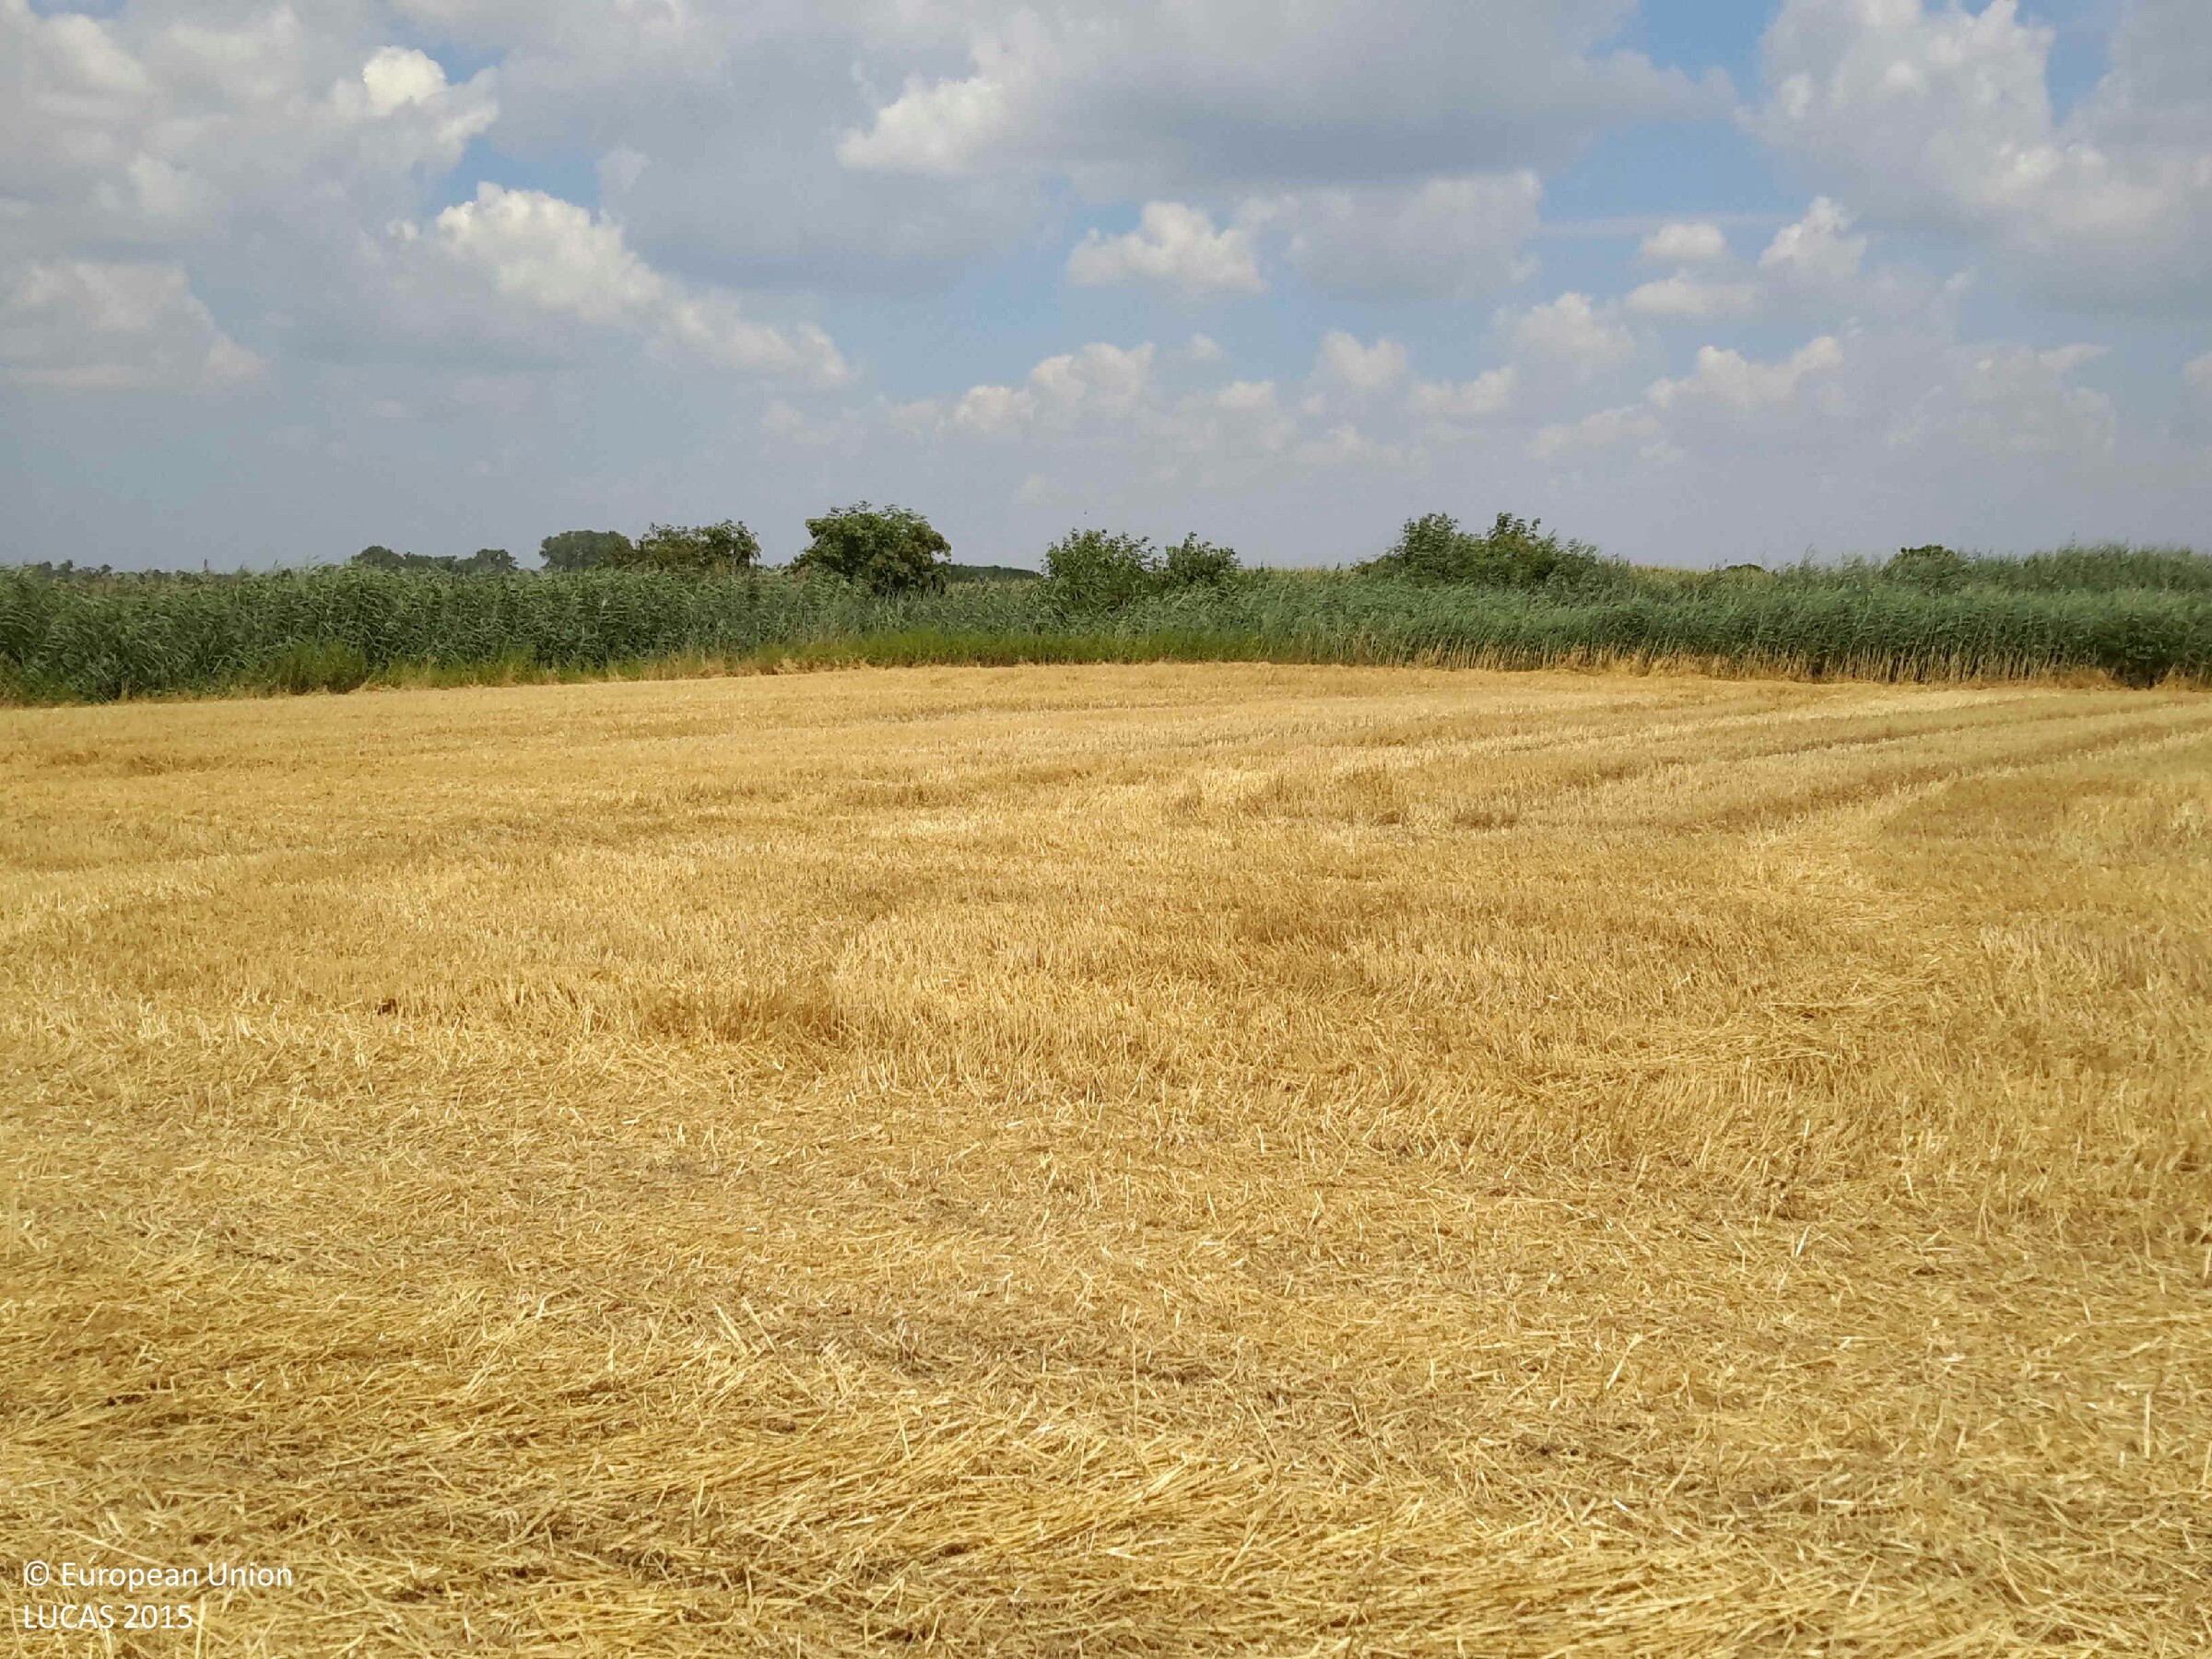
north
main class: Cropland
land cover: Common wheat
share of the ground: 50 - 75 %
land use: Agriculture (excluding fallow land and kitchen gardens)
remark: Harvested field
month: July
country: HU
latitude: 47.5862
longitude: 17.7885
